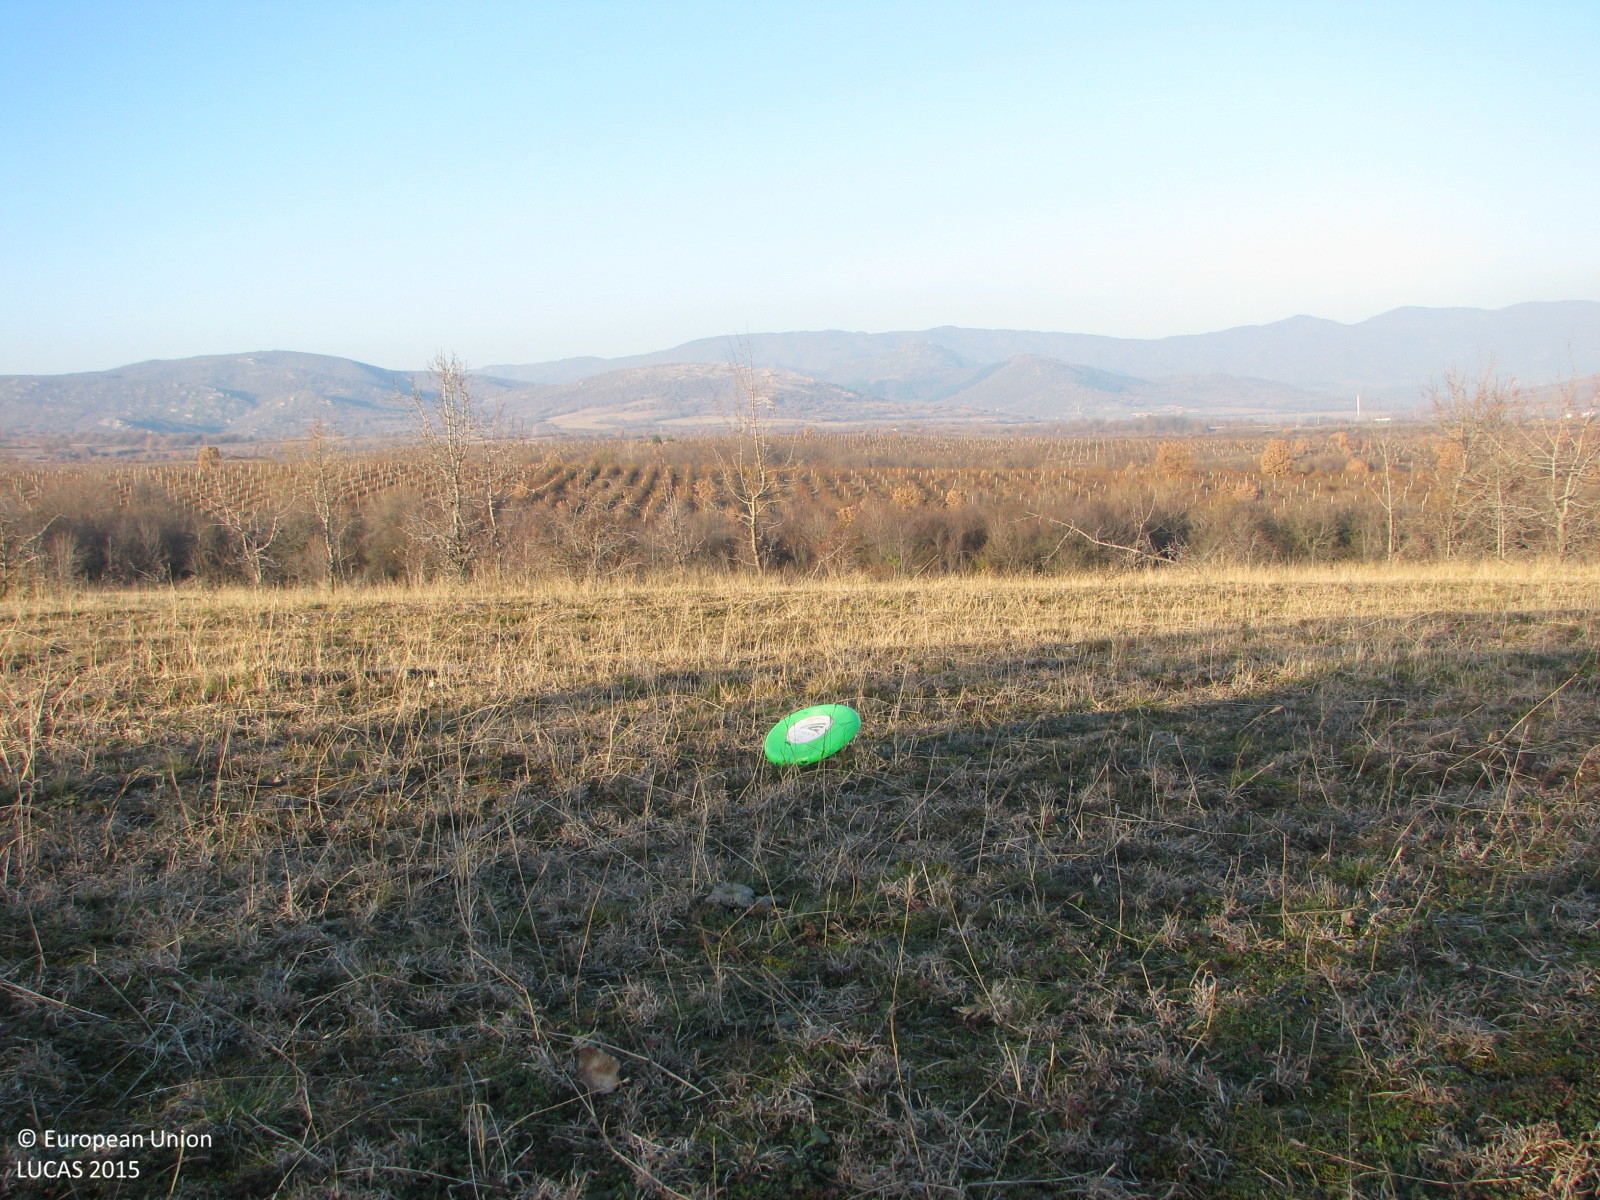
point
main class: Grassland
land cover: Grassland with sparse tree/shrub cover
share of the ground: > 75 %
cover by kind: herbaceous plants 70 %, lichens and mosses 20 %, broadleaved forest trees 5 %, shrubs 5 %
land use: Agriculture (excluding fallow land and kitchen gardens)
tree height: < 5 m
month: December
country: BG
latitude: 42.4001
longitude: 25.0646
